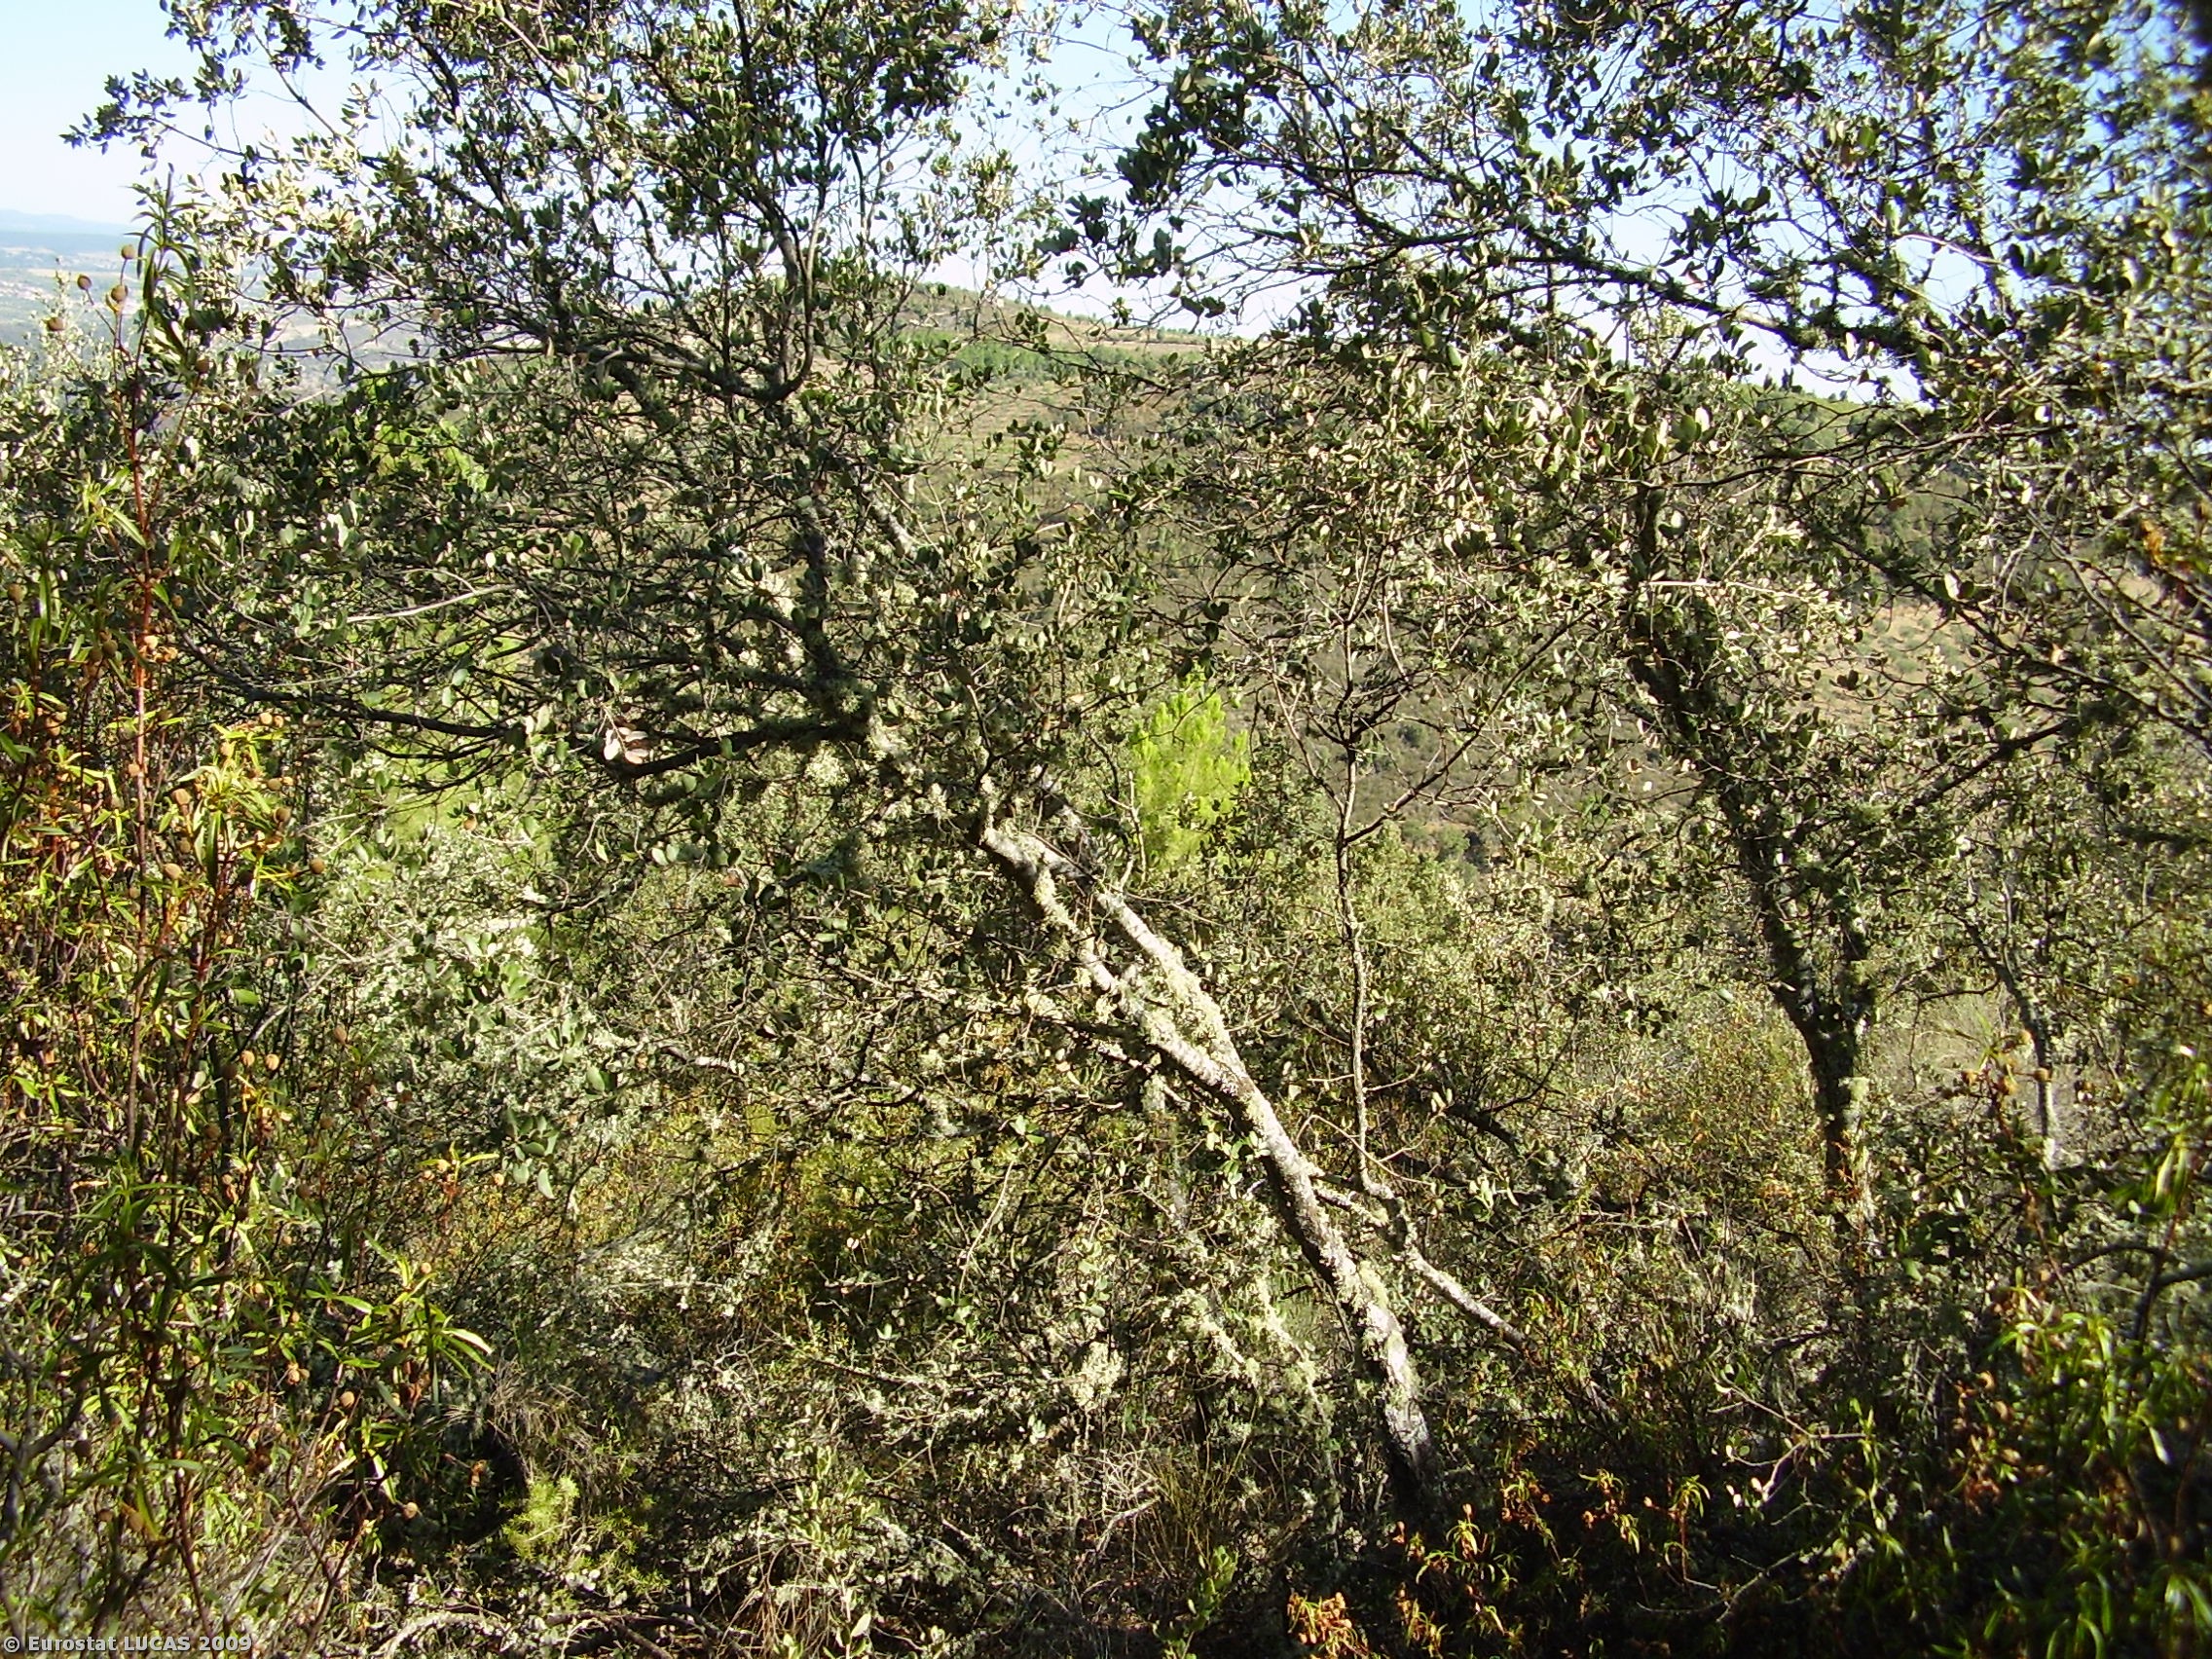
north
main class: Woodland
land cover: Broadleaved woodland
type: broadleaved evergreen forest
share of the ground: 10 - 25 %
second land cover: Shrubland with sparse tree cover
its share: > 75 %
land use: Forestry
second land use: Fallow land
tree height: > 5 m
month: August
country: PT
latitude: 41.3958
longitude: -6.7436
